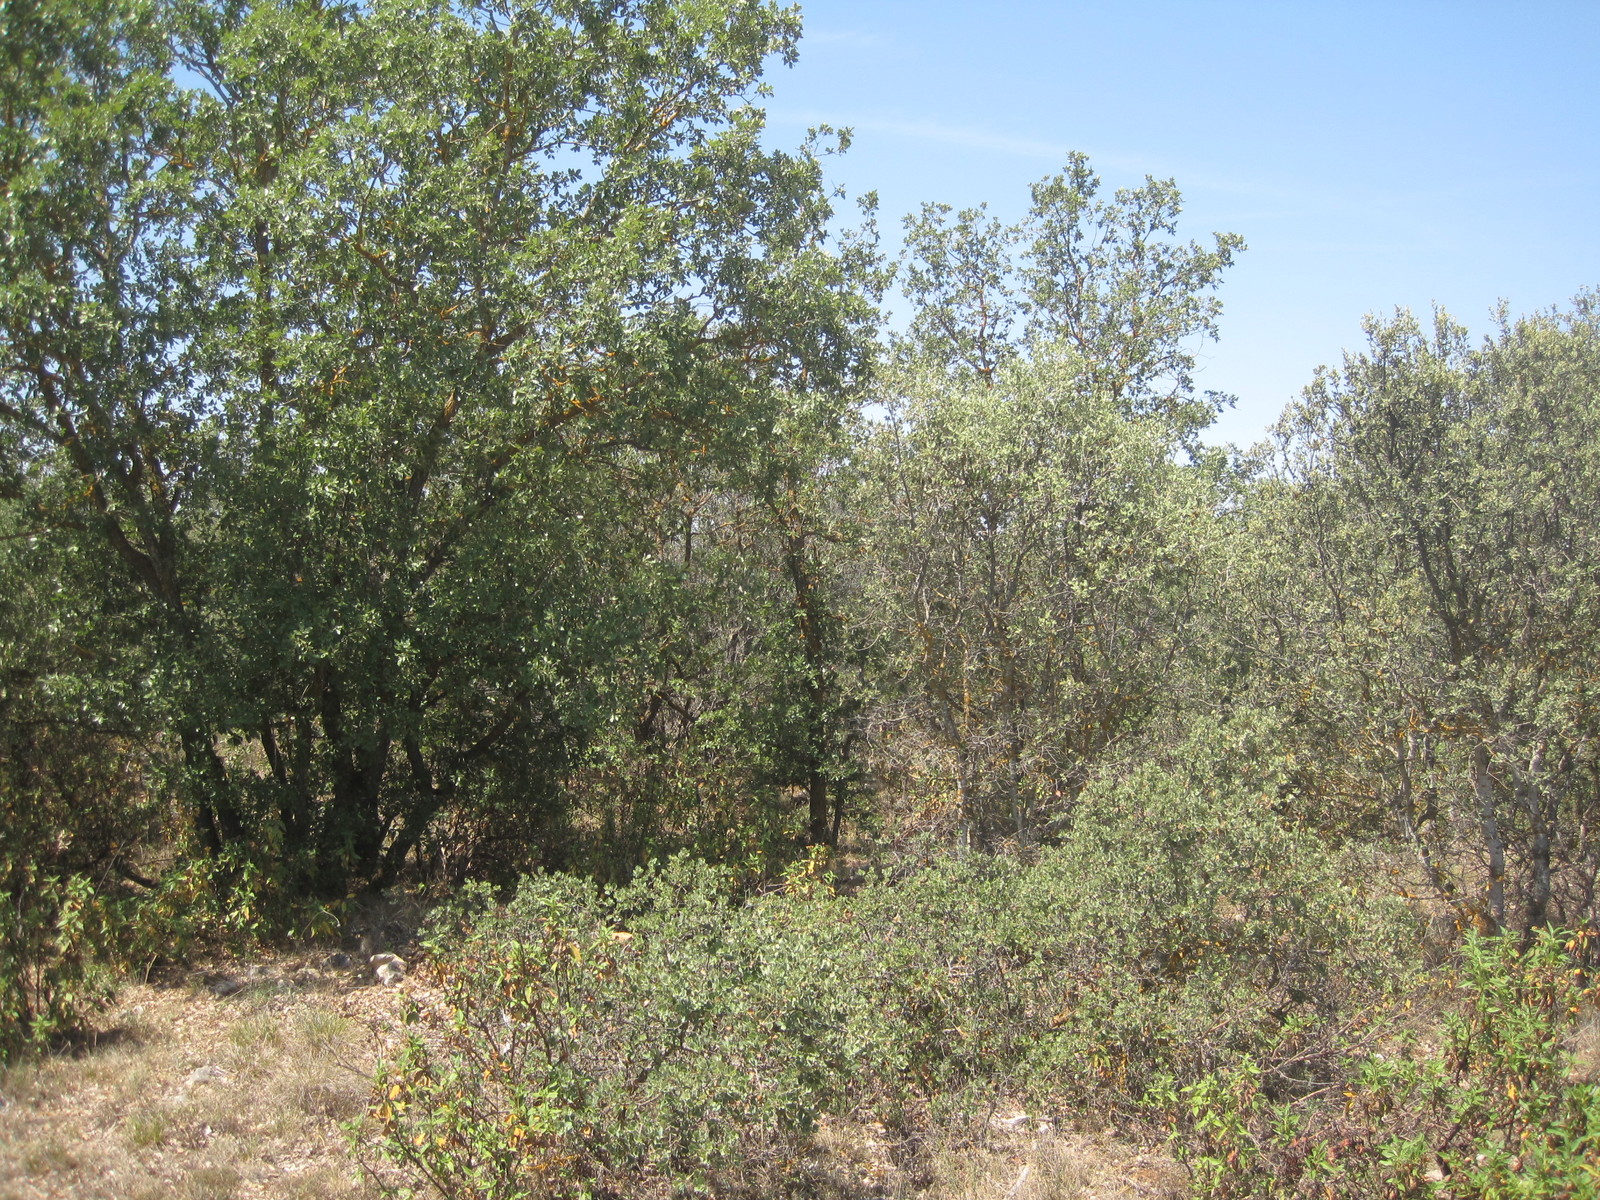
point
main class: Woodland
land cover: Broadleaved woodland
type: broadleaved evergreen forest
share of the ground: 50 - 75 %
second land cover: Grassland without tree/shrub cover
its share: 50 - 75 %
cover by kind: broadleaved forest trees 70 %, herbaceous plants 30 %
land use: Forestry
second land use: Agriculture (excluding fallow land and kitchen gardens)
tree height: > 5 m
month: July
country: ES
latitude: 41.7672
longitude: -5.1262
